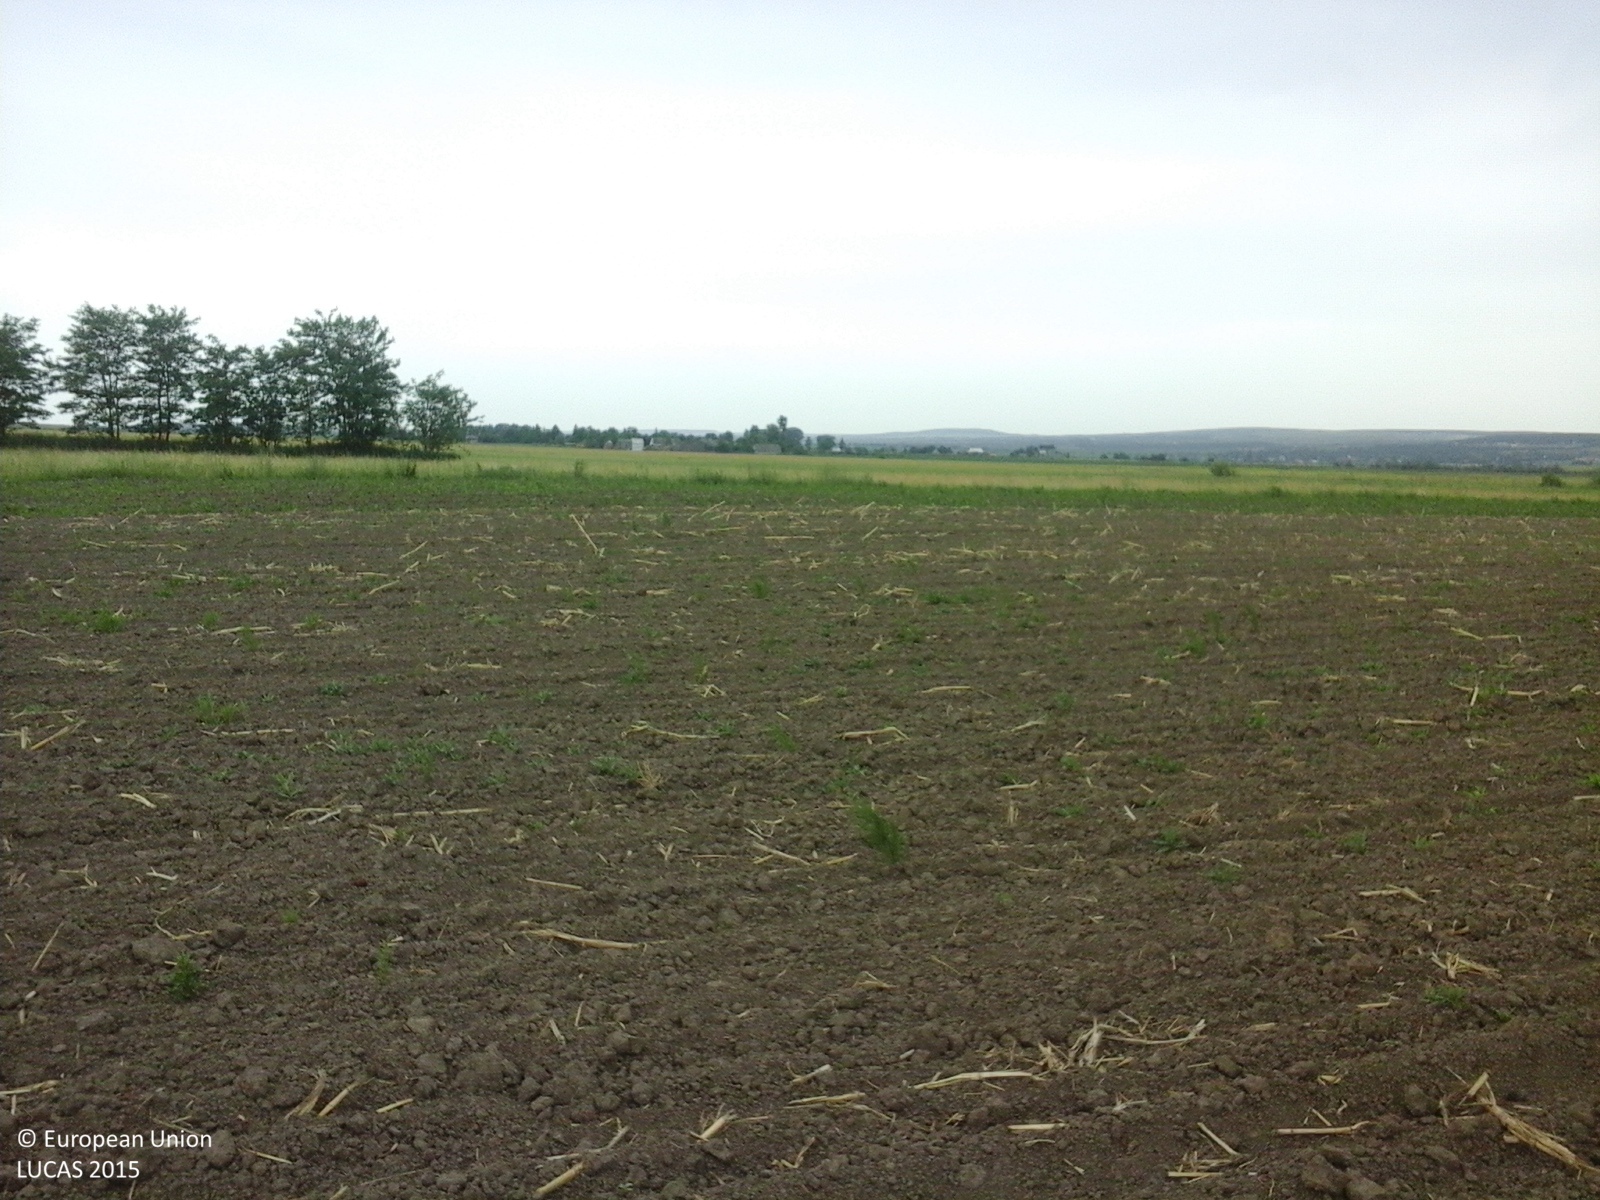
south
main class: Cropland
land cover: Sunflower
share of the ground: < 10 %
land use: Agriculture (excluding fallow land and kitchen gardens)
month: June
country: RO
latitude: 47.3237
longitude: 26.6983
